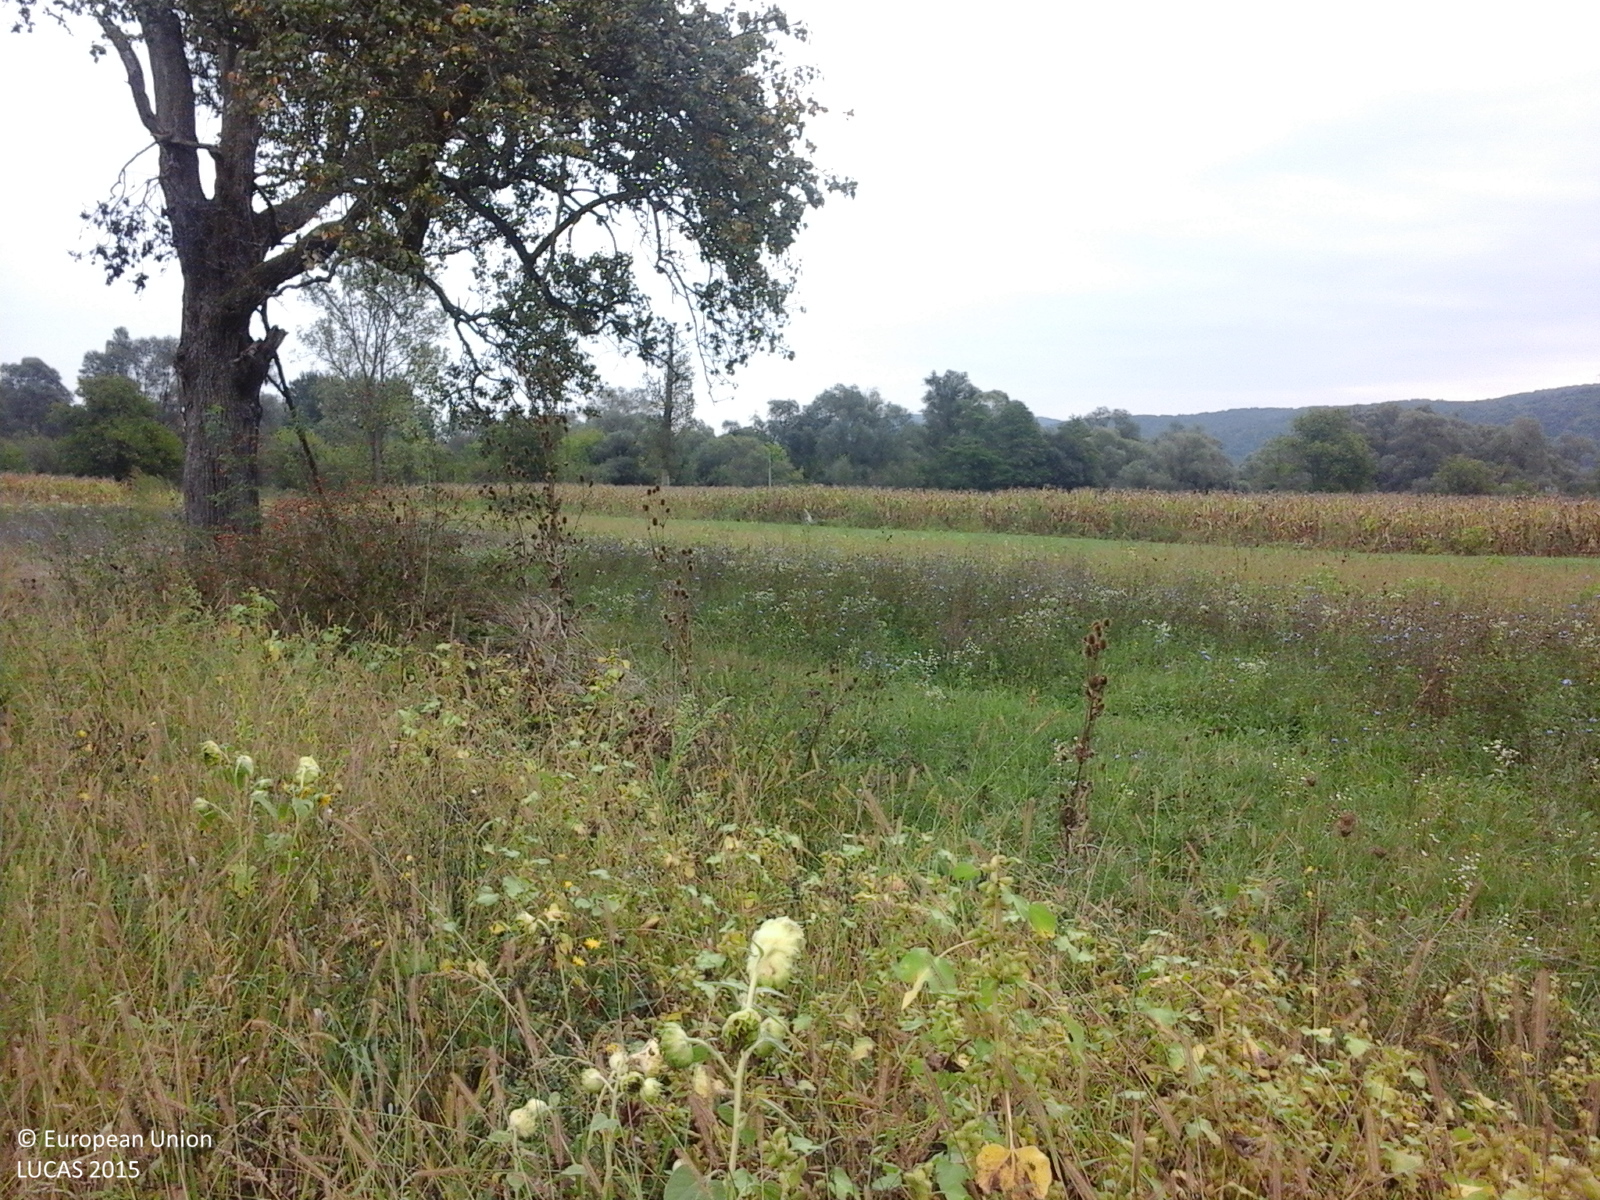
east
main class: Grassland
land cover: Spontaneously vegetated surfaces
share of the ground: > 75 %
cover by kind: herbaceous plants 100 %
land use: Fallow land
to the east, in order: Spontaneously vegetated surfaces; Lucerne; Spontaneously vegetated surfaces; Lucerne; Maize; Tracks; Grass margins; Electric lines; Ditches and canals; Grass margins; Paved roads, cycling and walking lanes; Grass margins; Other fruit trees and berries; Shrubland with sparse tree cover; Inland fresh running water; Broadleaved woodland
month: September
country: RO
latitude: 45.9877
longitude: 22.2705
